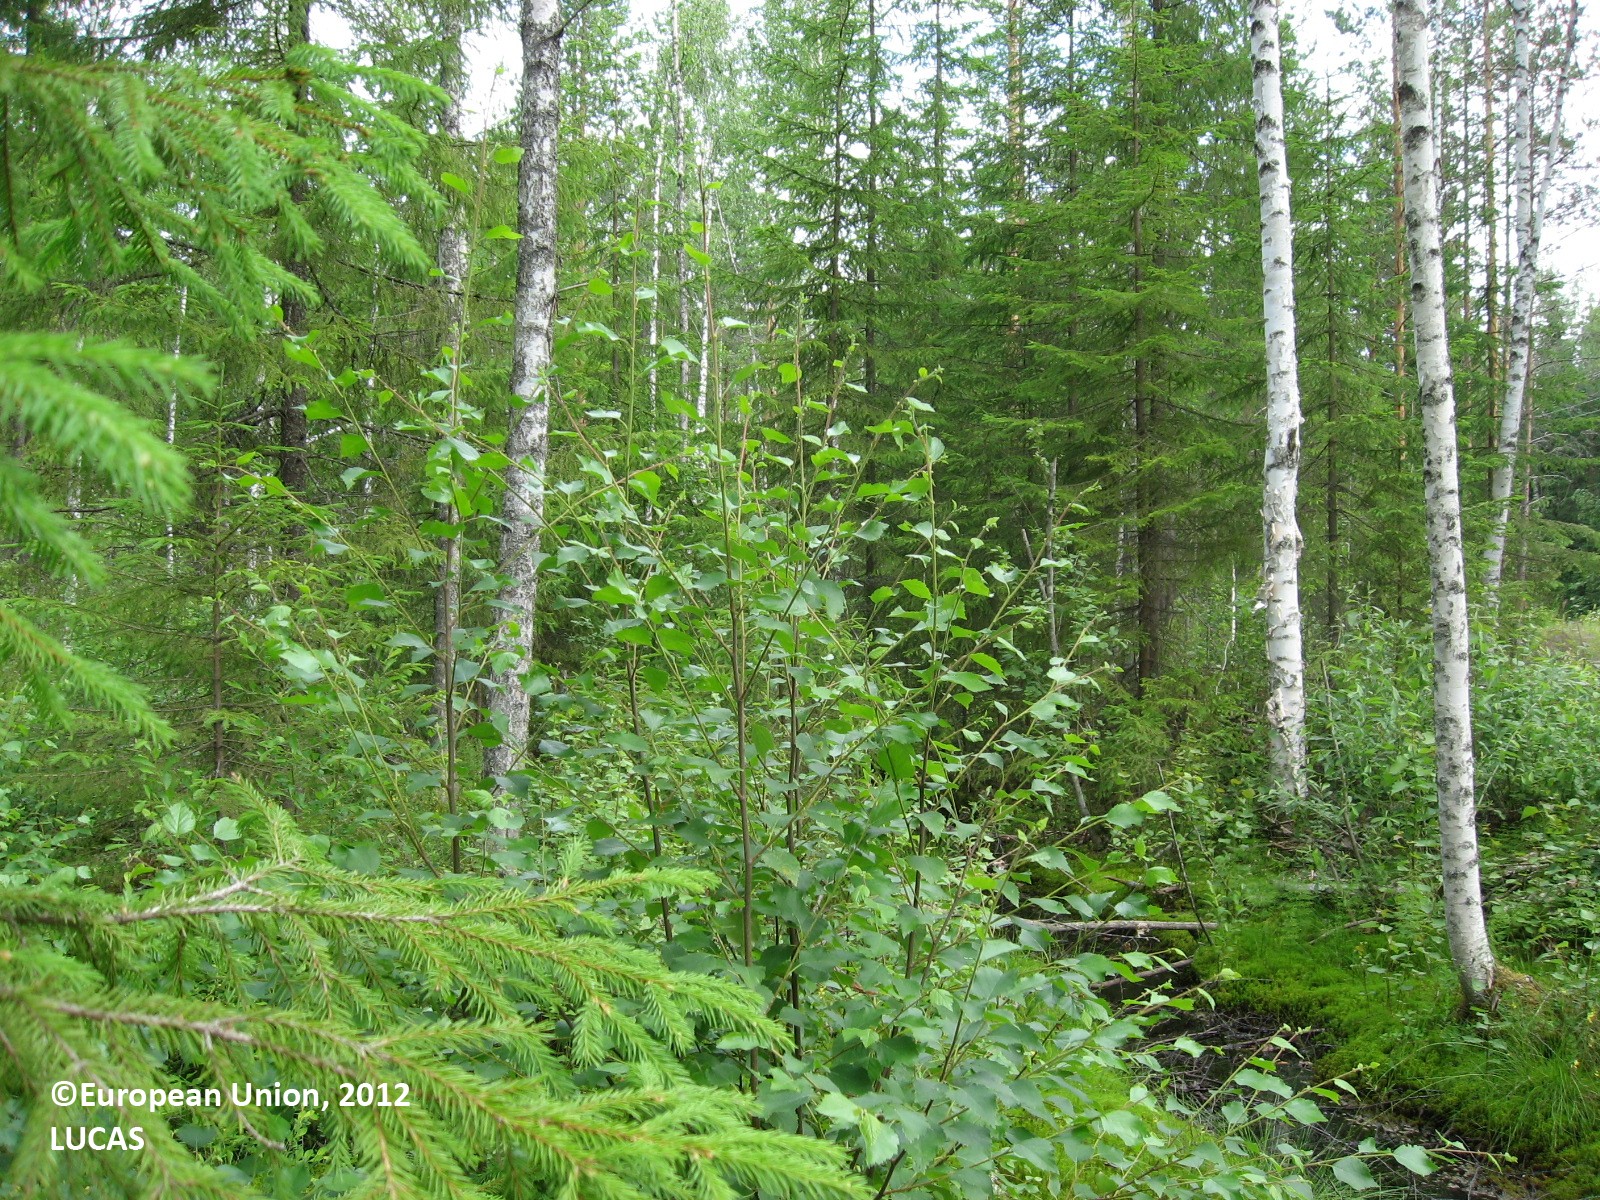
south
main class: Woodland
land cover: Other mixed woodland
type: mire and swamp forests
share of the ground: 25 - 50 %
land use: Forestry
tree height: > 5 m
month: July
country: FI
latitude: 60.8927
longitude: 26.5370
